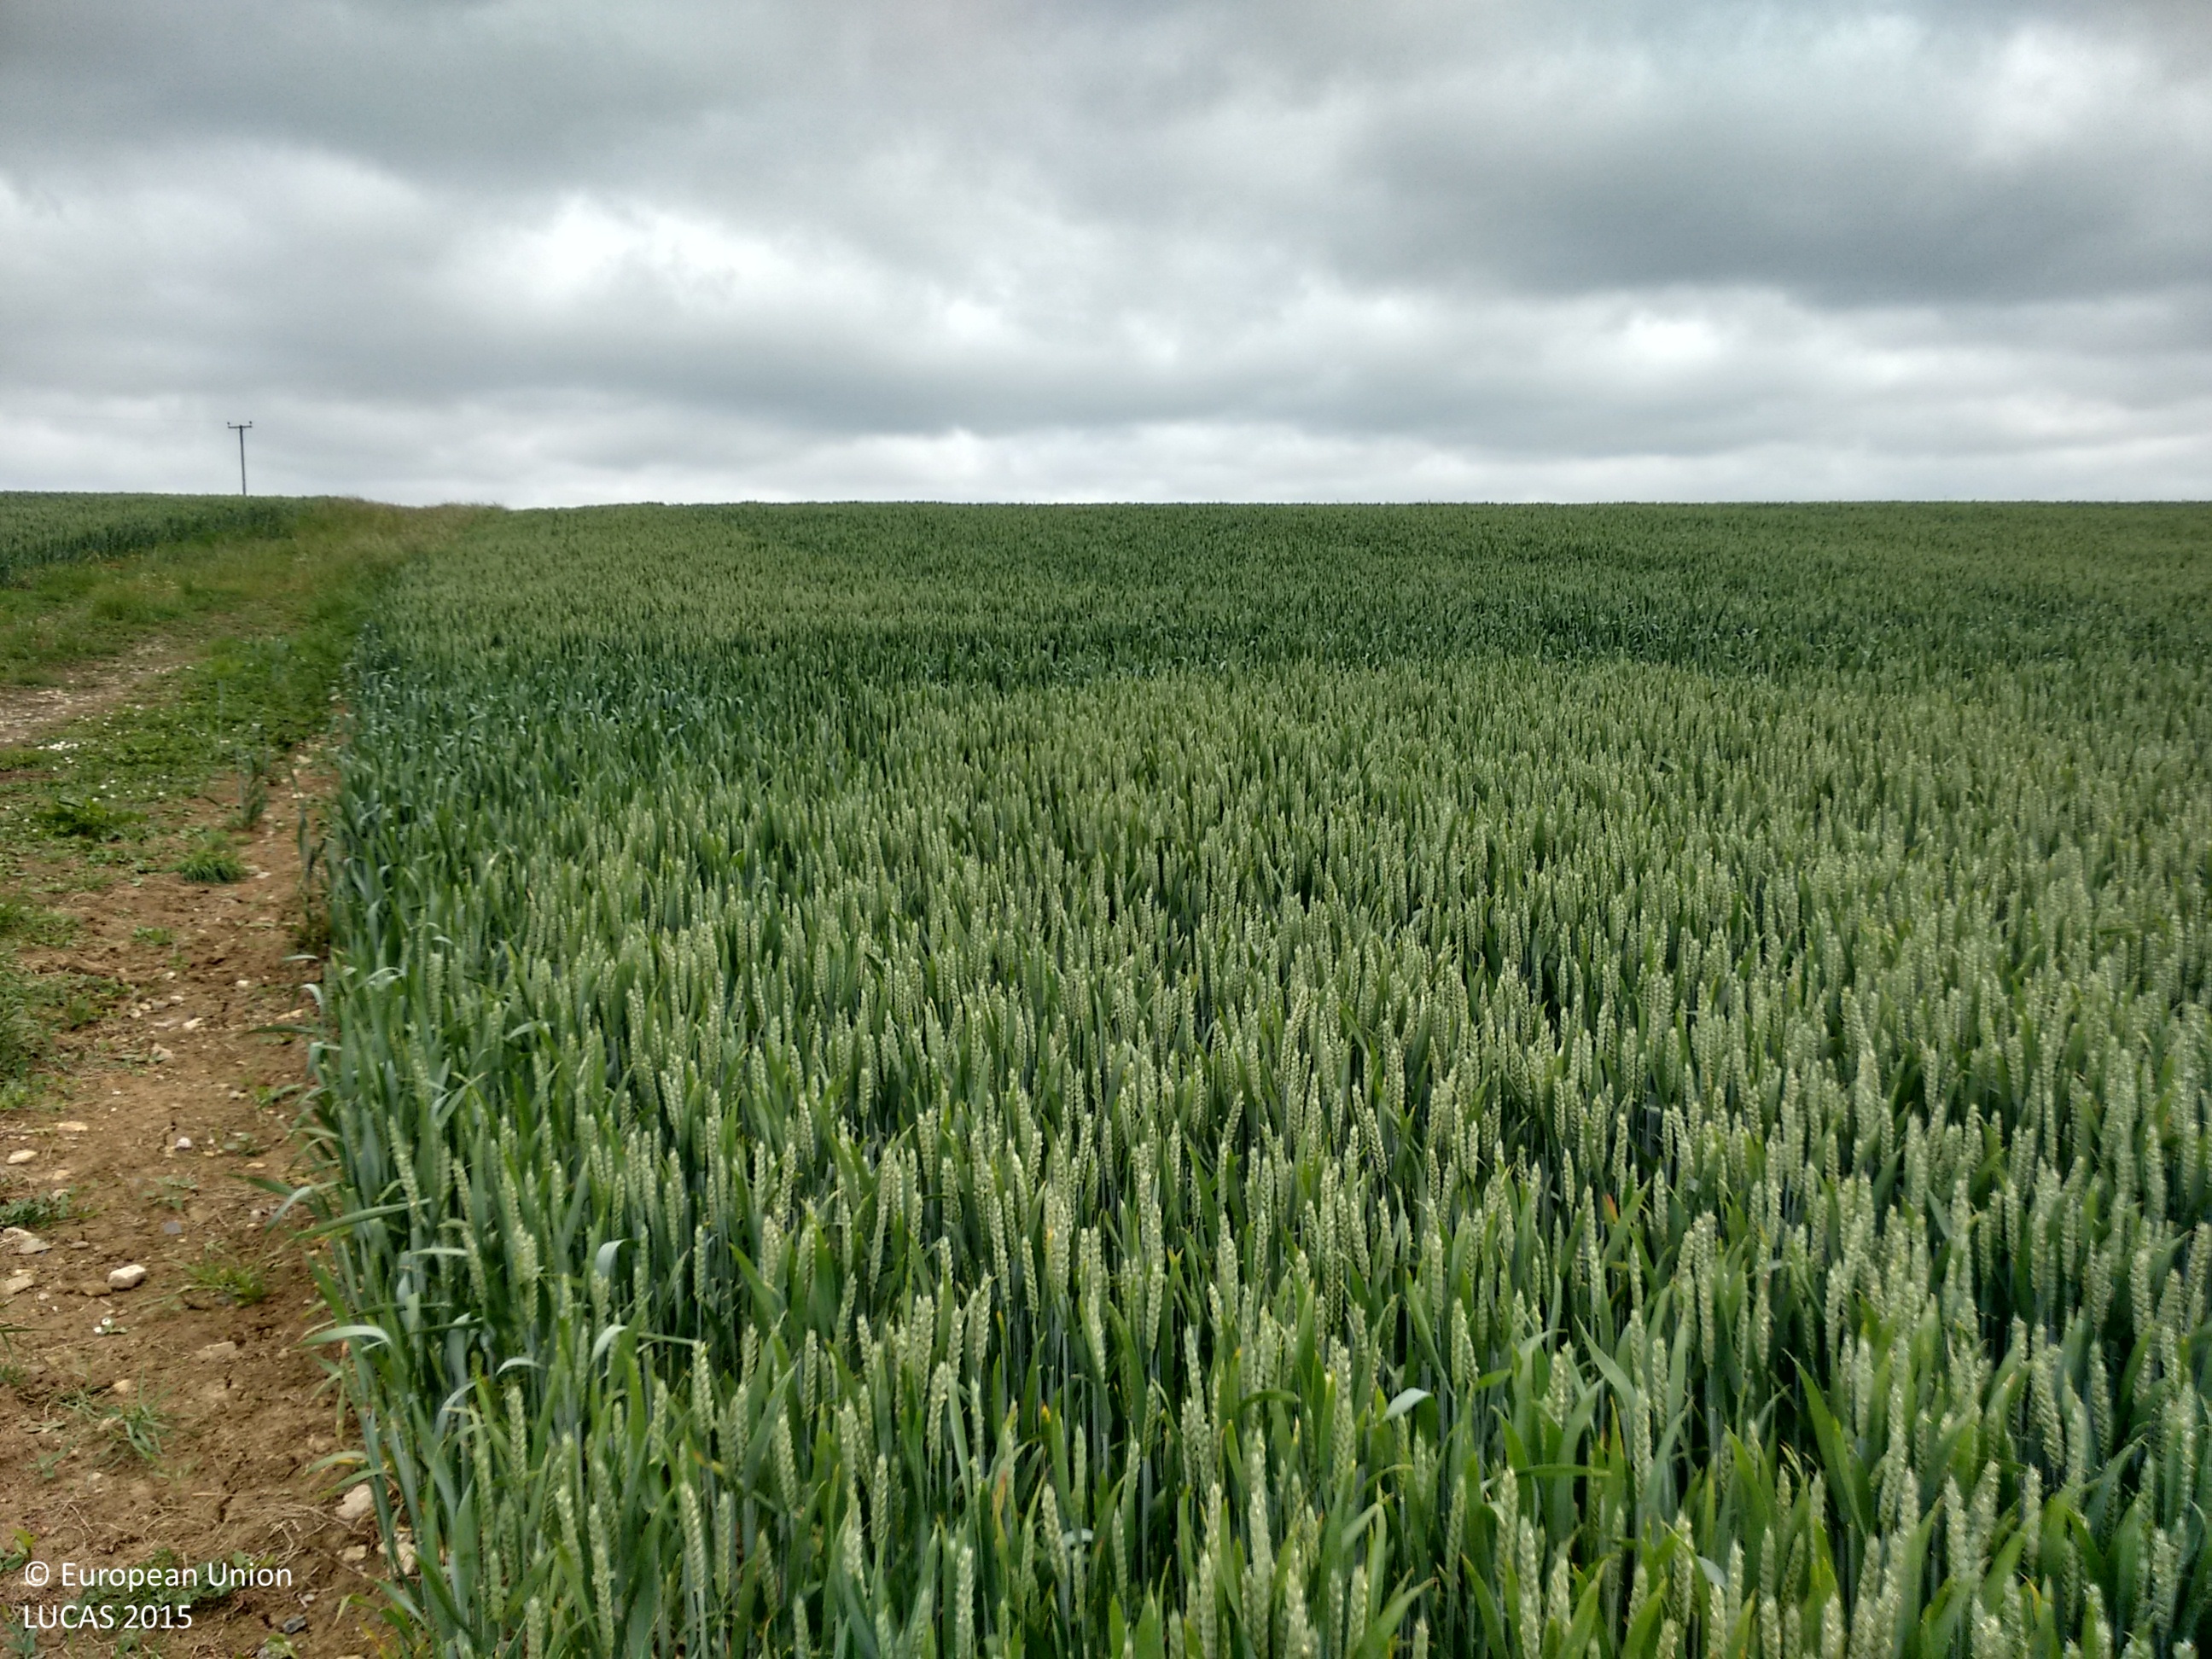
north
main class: Cropland
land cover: Common wheat
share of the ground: > 75 %
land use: Agriculture (excluding fallow land and kitchen gardens)
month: June
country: GB
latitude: 51.0651
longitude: -2.4371
